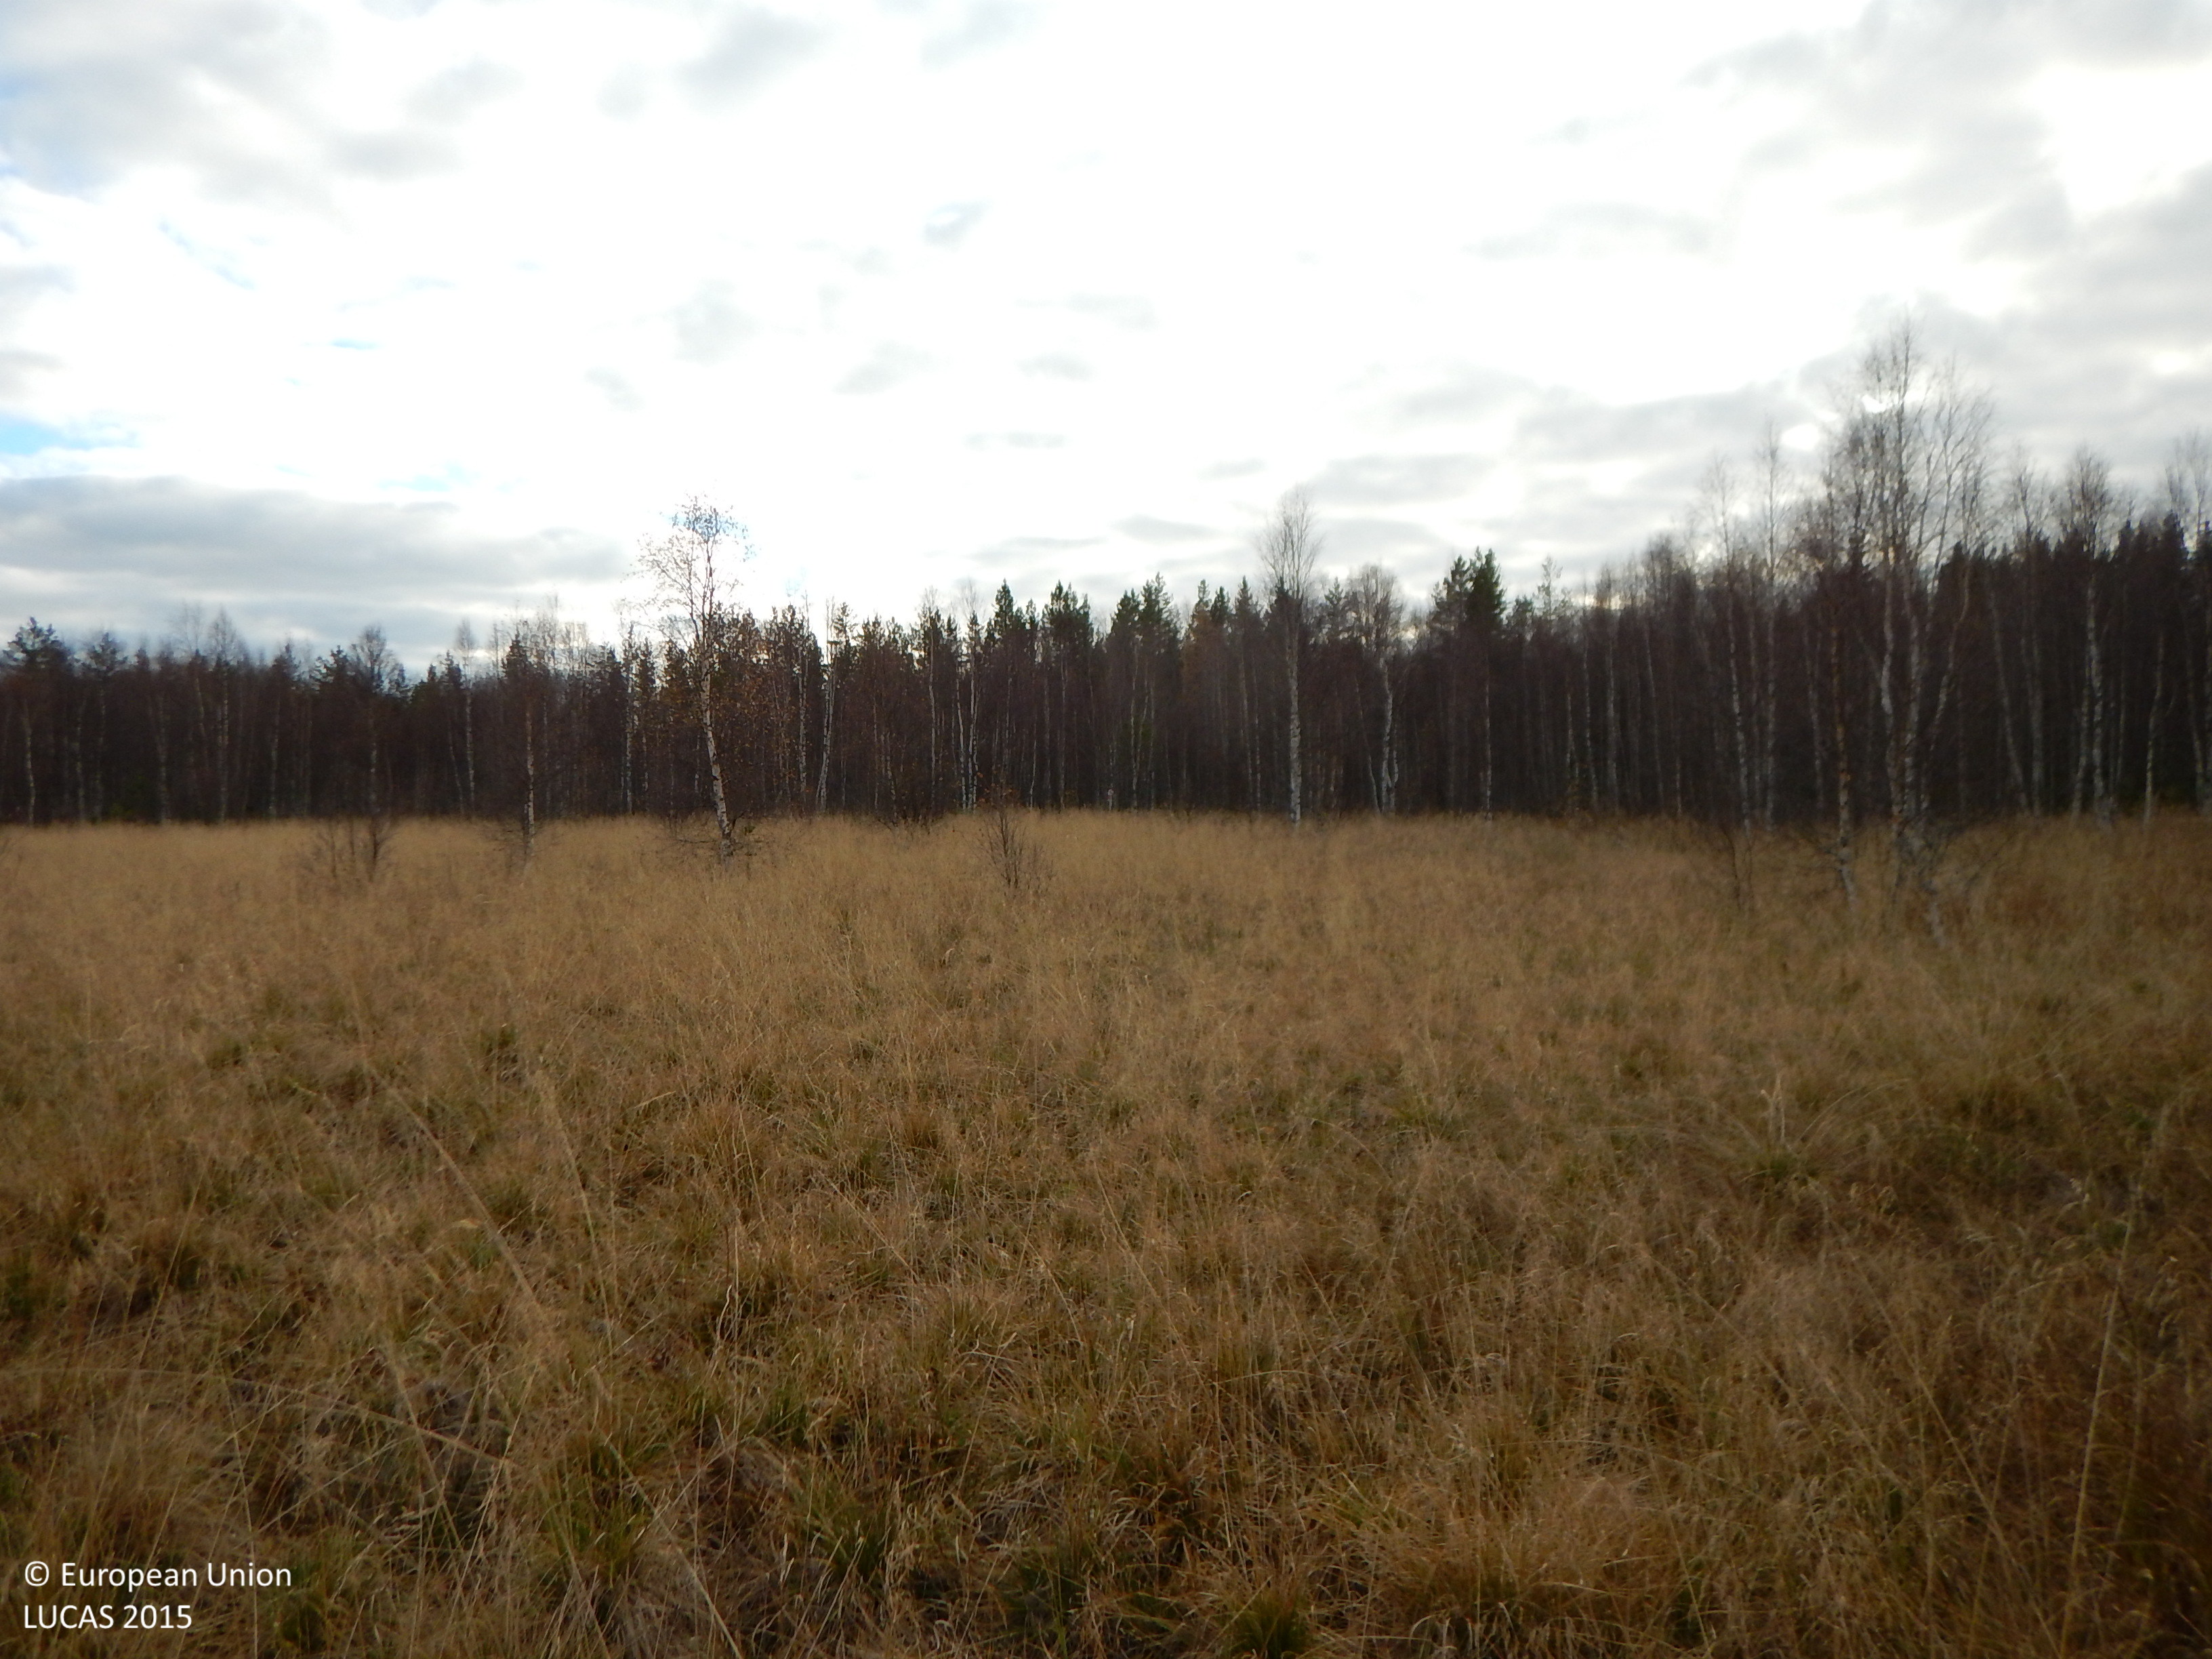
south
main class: Grassland
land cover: Grassland with sparse tree/shrub cover
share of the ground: > 75 %
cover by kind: herbaceous plants 70 %, lichens and mosses 20 %, broadleaved forest trees 5 %, shrubs 5 %
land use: Abandoned areas
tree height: > 5 m
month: October
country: SE
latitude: 65.1274
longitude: 21.0336
